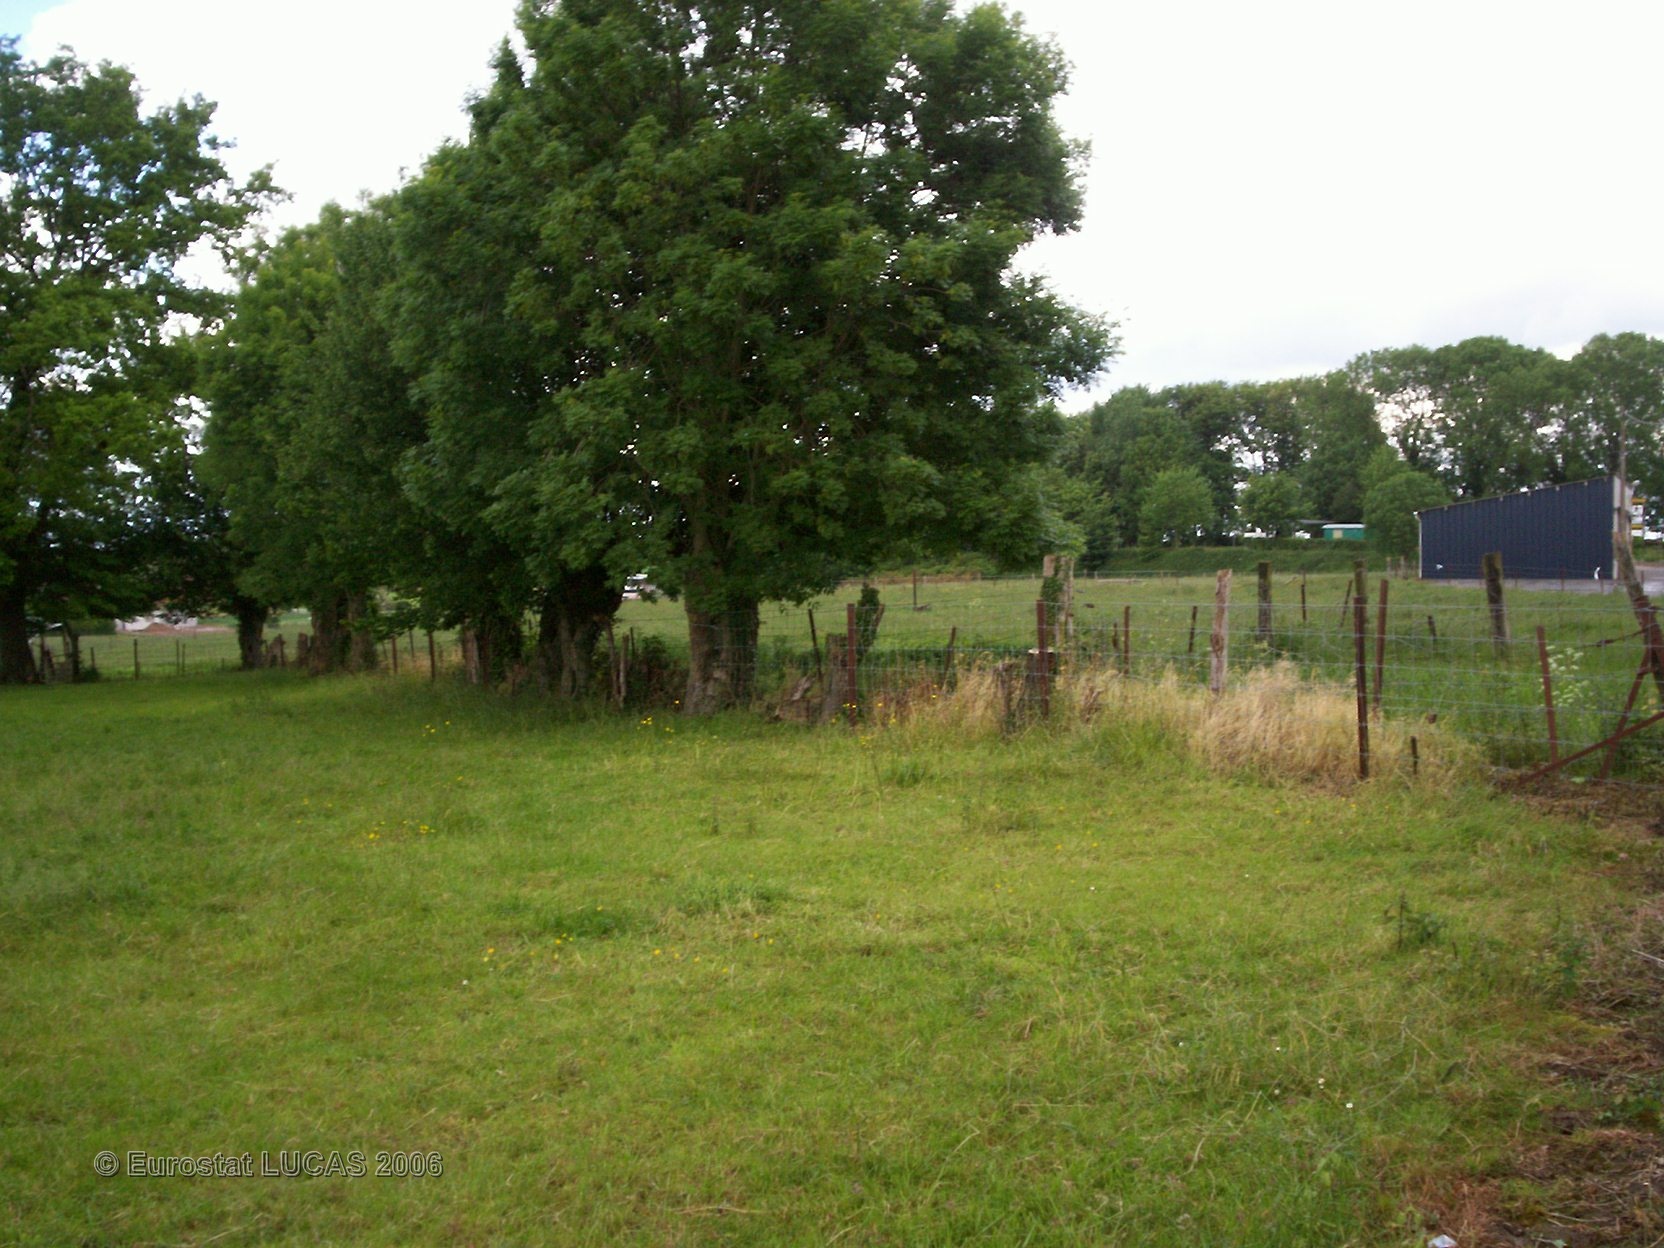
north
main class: Grassland
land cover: Grassland with sparse tree/shrub cover
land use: Agriculture (excluding fallow land and kitchen gardens)
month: May
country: FR
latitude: 50.1825
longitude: 2.6641
